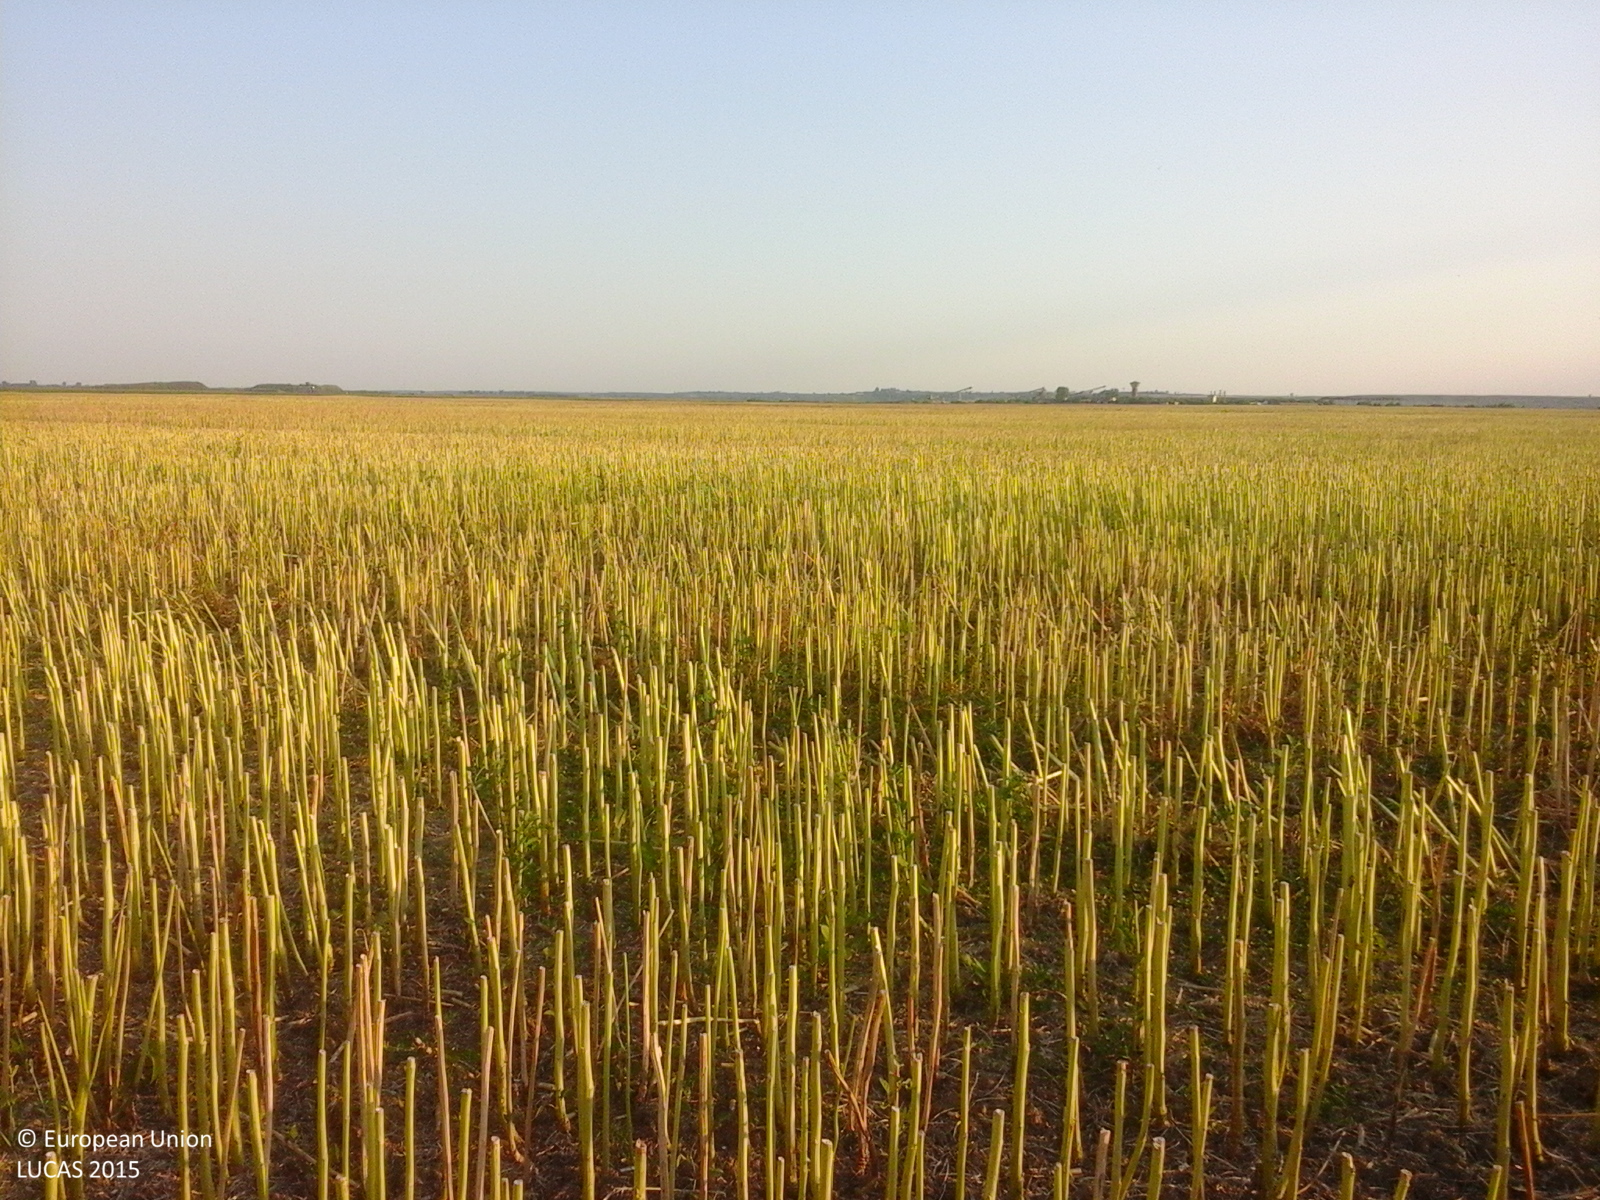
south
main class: Cropland
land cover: Rape and turnip rape
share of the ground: < 10 %
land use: Agriculture (excluding fallow land and kitchen gardens)
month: July
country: RO
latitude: 44.3559
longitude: 24.3315
